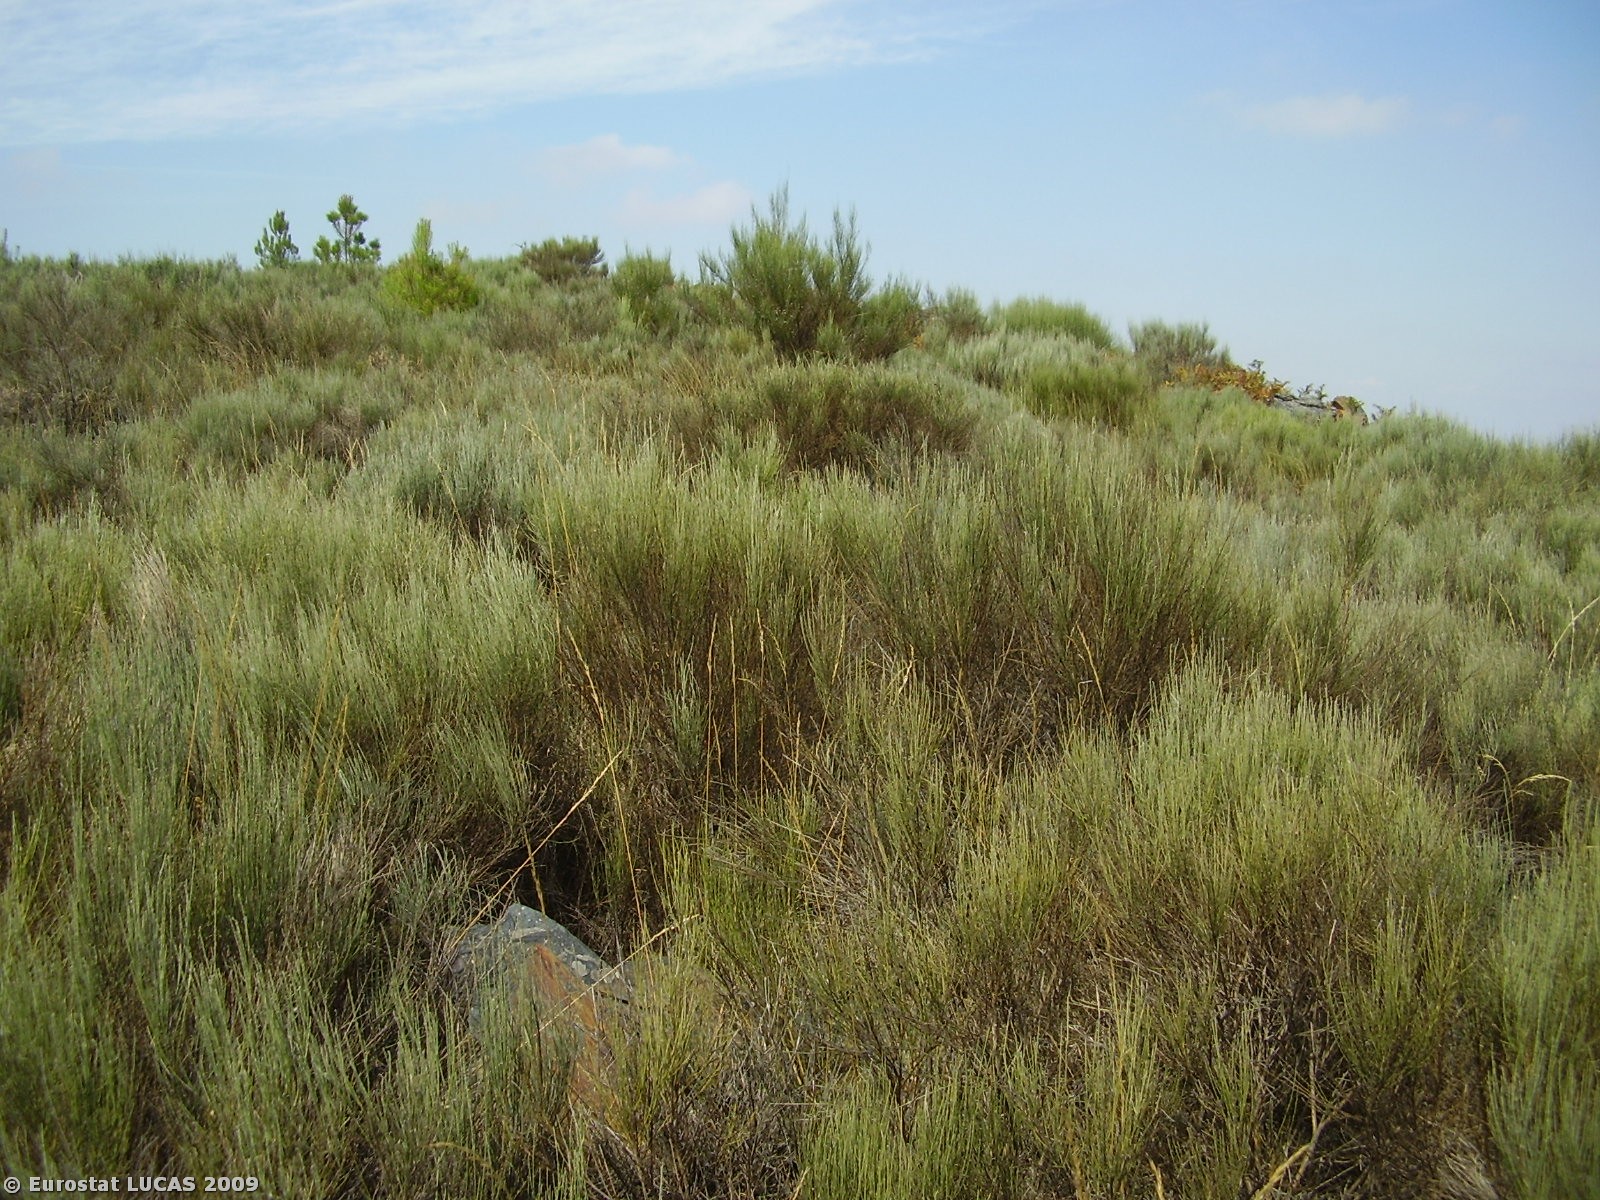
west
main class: Shrubland
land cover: Shrubland with sparse tree cover
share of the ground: > 75 %
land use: Fallow land
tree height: > 5 m
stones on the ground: 25 - 50 %
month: September
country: PT
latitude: 41.1720
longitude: -6.9751
